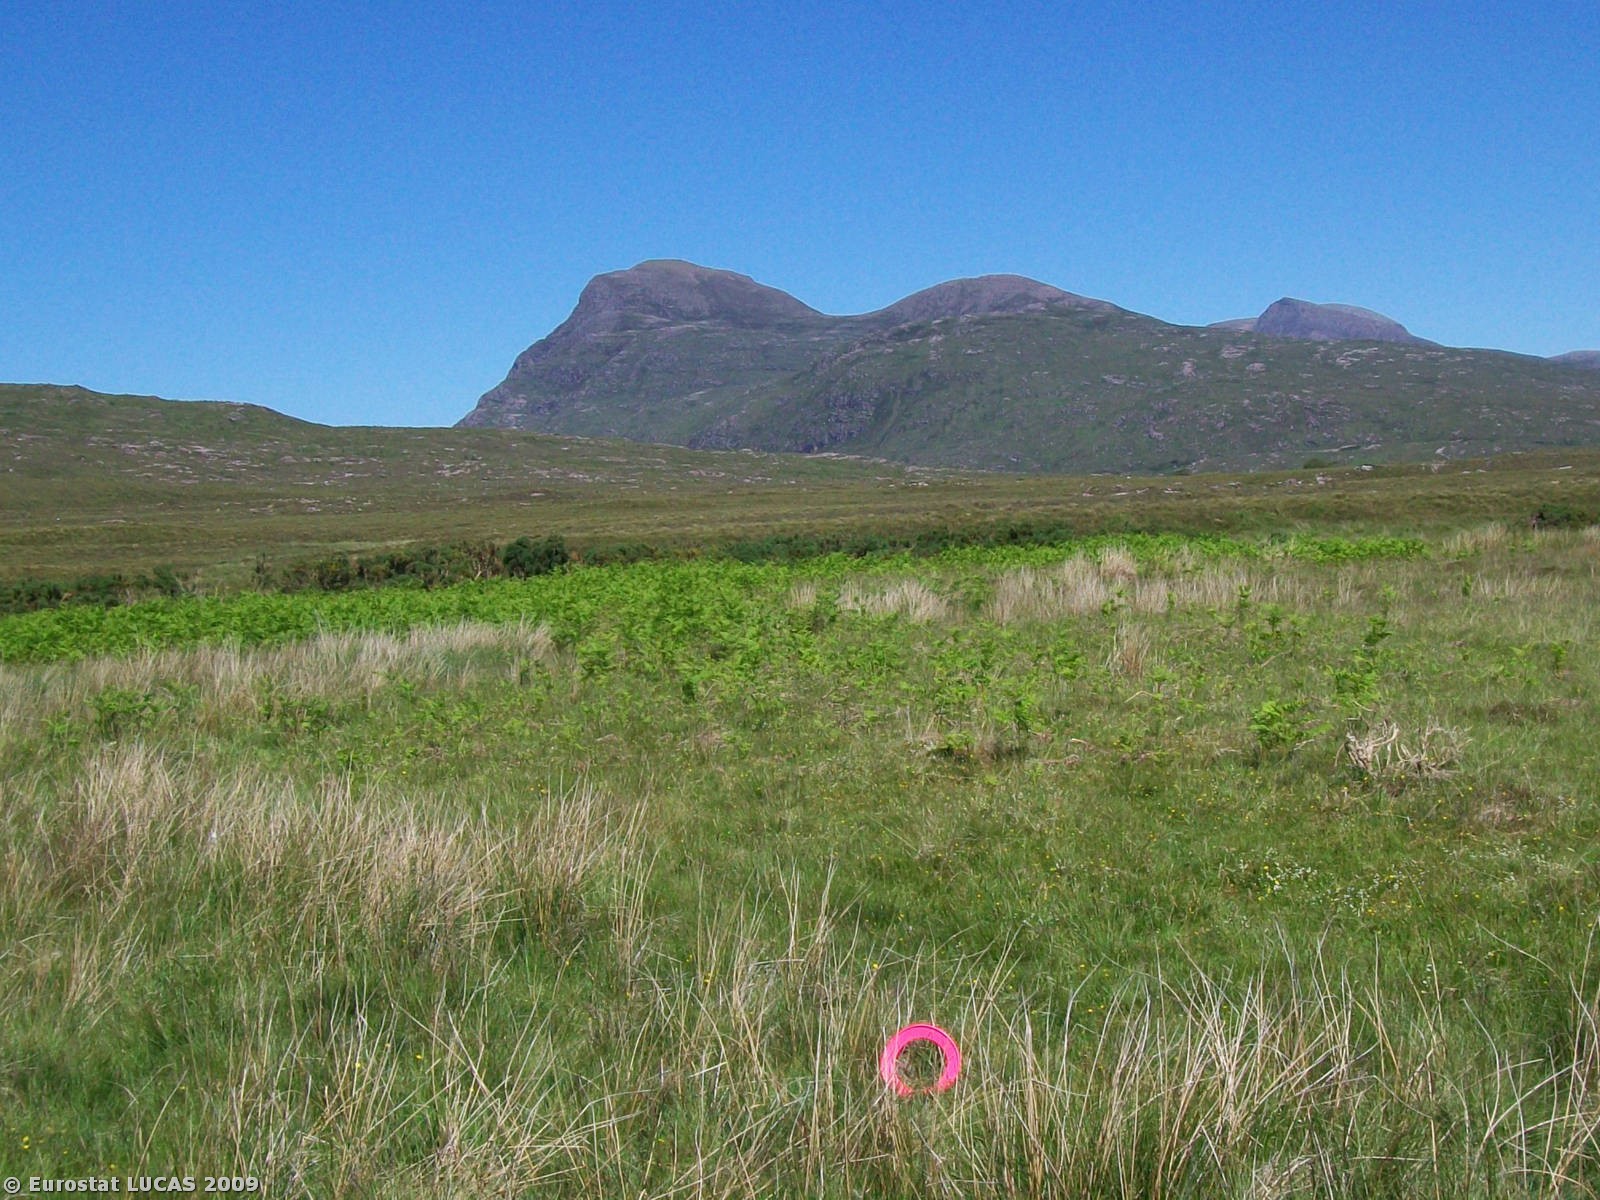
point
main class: Grassland
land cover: Grassland without tree/shrub cover
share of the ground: > 75 %
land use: Fallow land
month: June
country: GB
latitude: 57.9790
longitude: -5.1355
